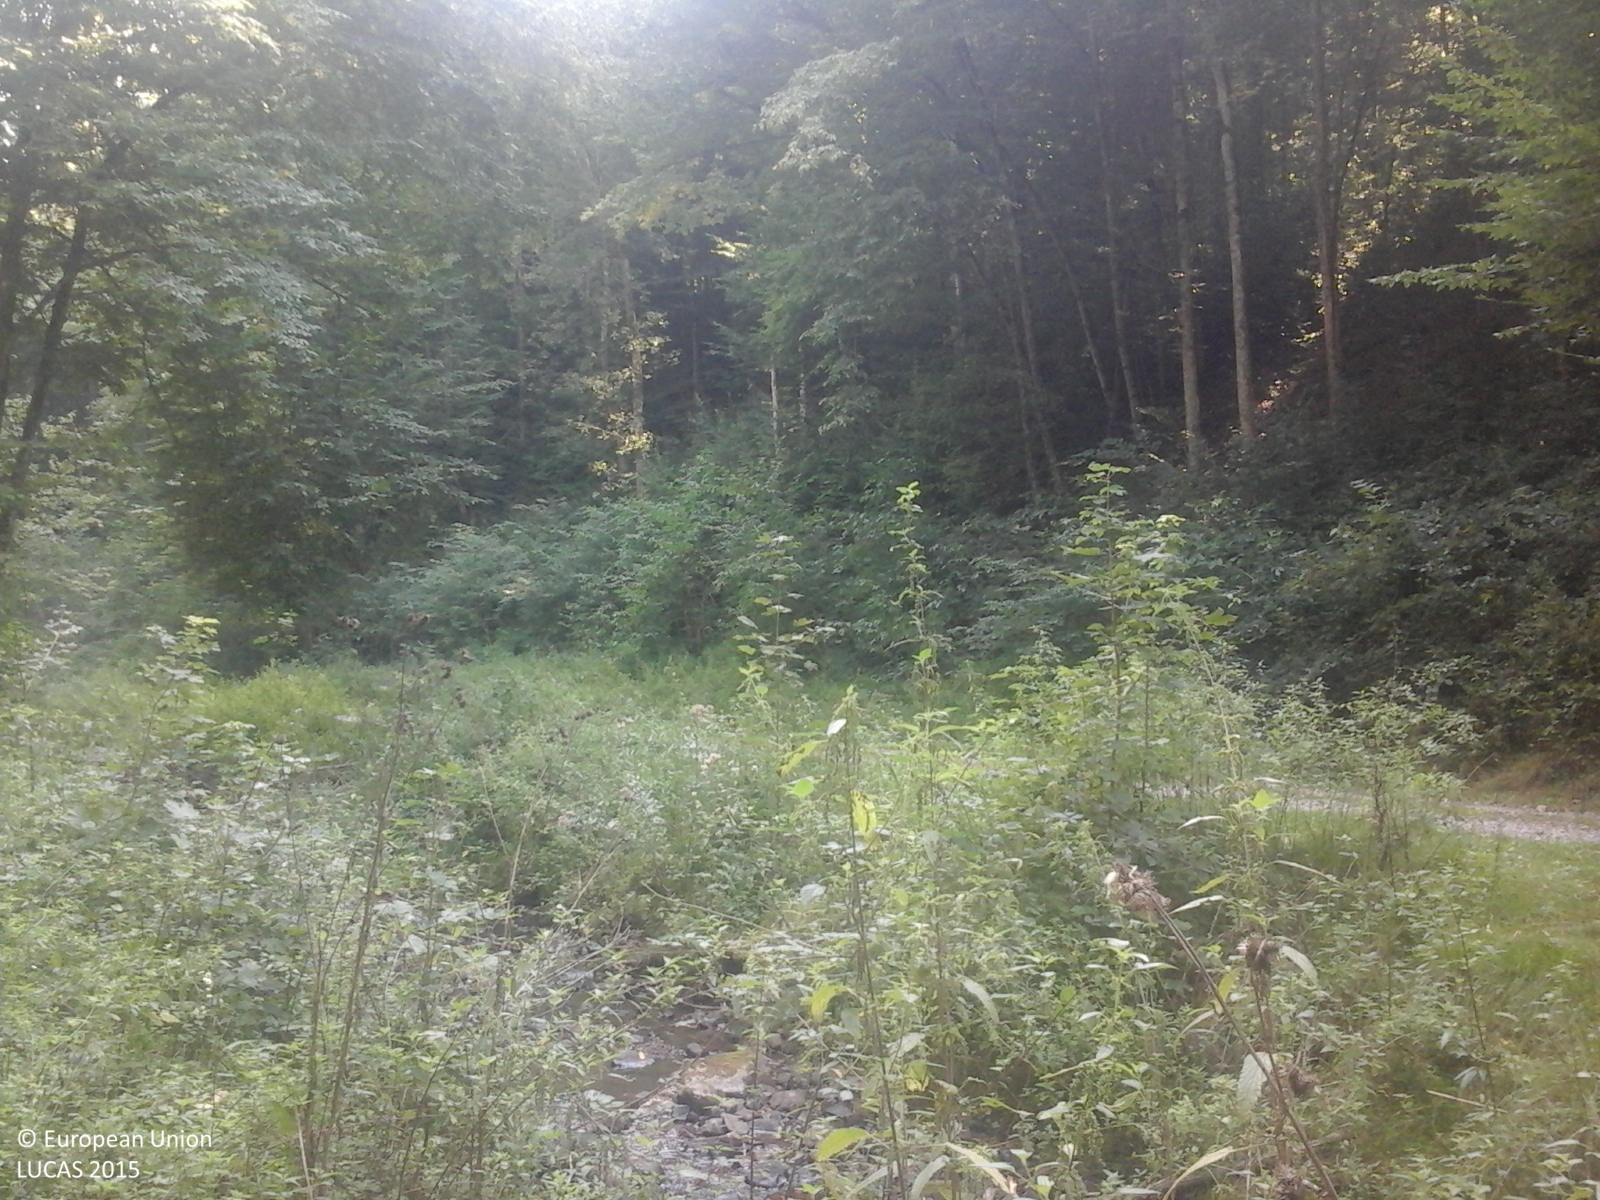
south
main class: Woodland
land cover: Broadleaved woodland
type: beech forest
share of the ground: > 75 %
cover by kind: broadleaved forest trees 100 %
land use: Forestry
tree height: > 5 m
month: August
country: RO
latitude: 46.5788
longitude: 22.1962
